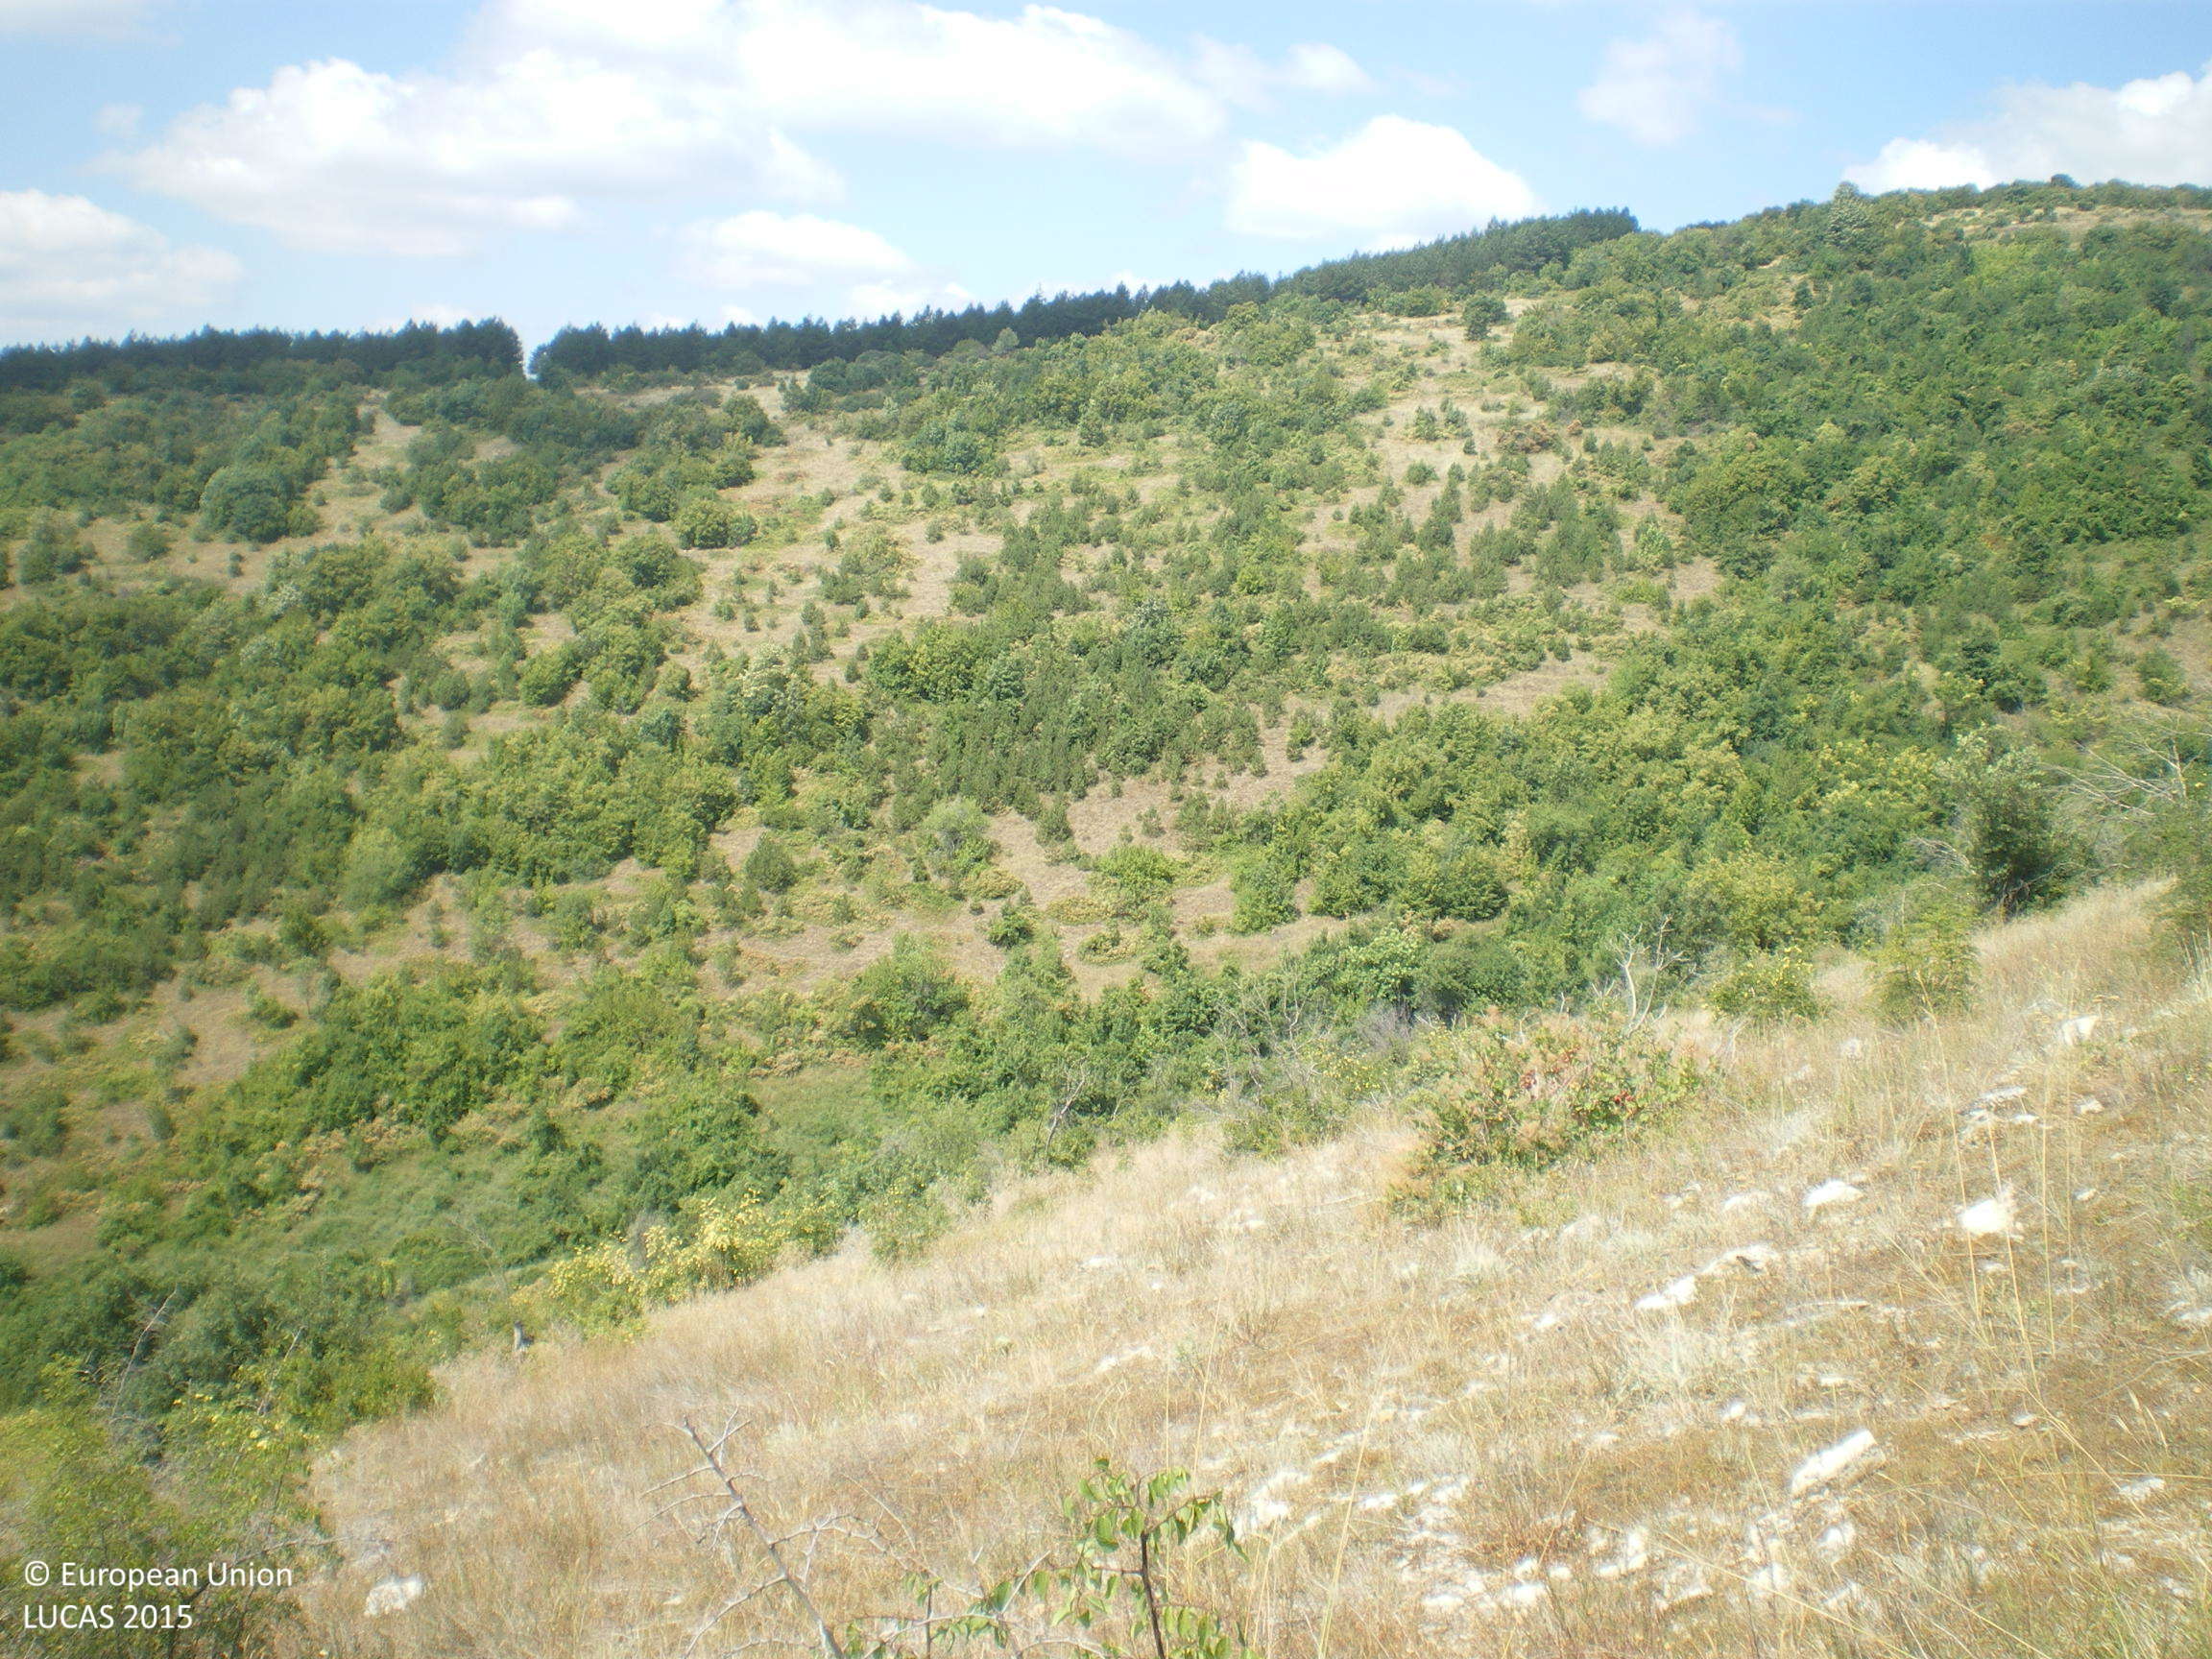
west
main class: Shrubland
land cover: Shrubland without tree cover
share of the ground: 10 - 25 %
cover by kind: herbaceous plants 90 %, shrubs 10 %
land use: Semi-natural and natural areas not in use
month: August
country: BG
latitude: 42.4328
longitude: 25.5690
